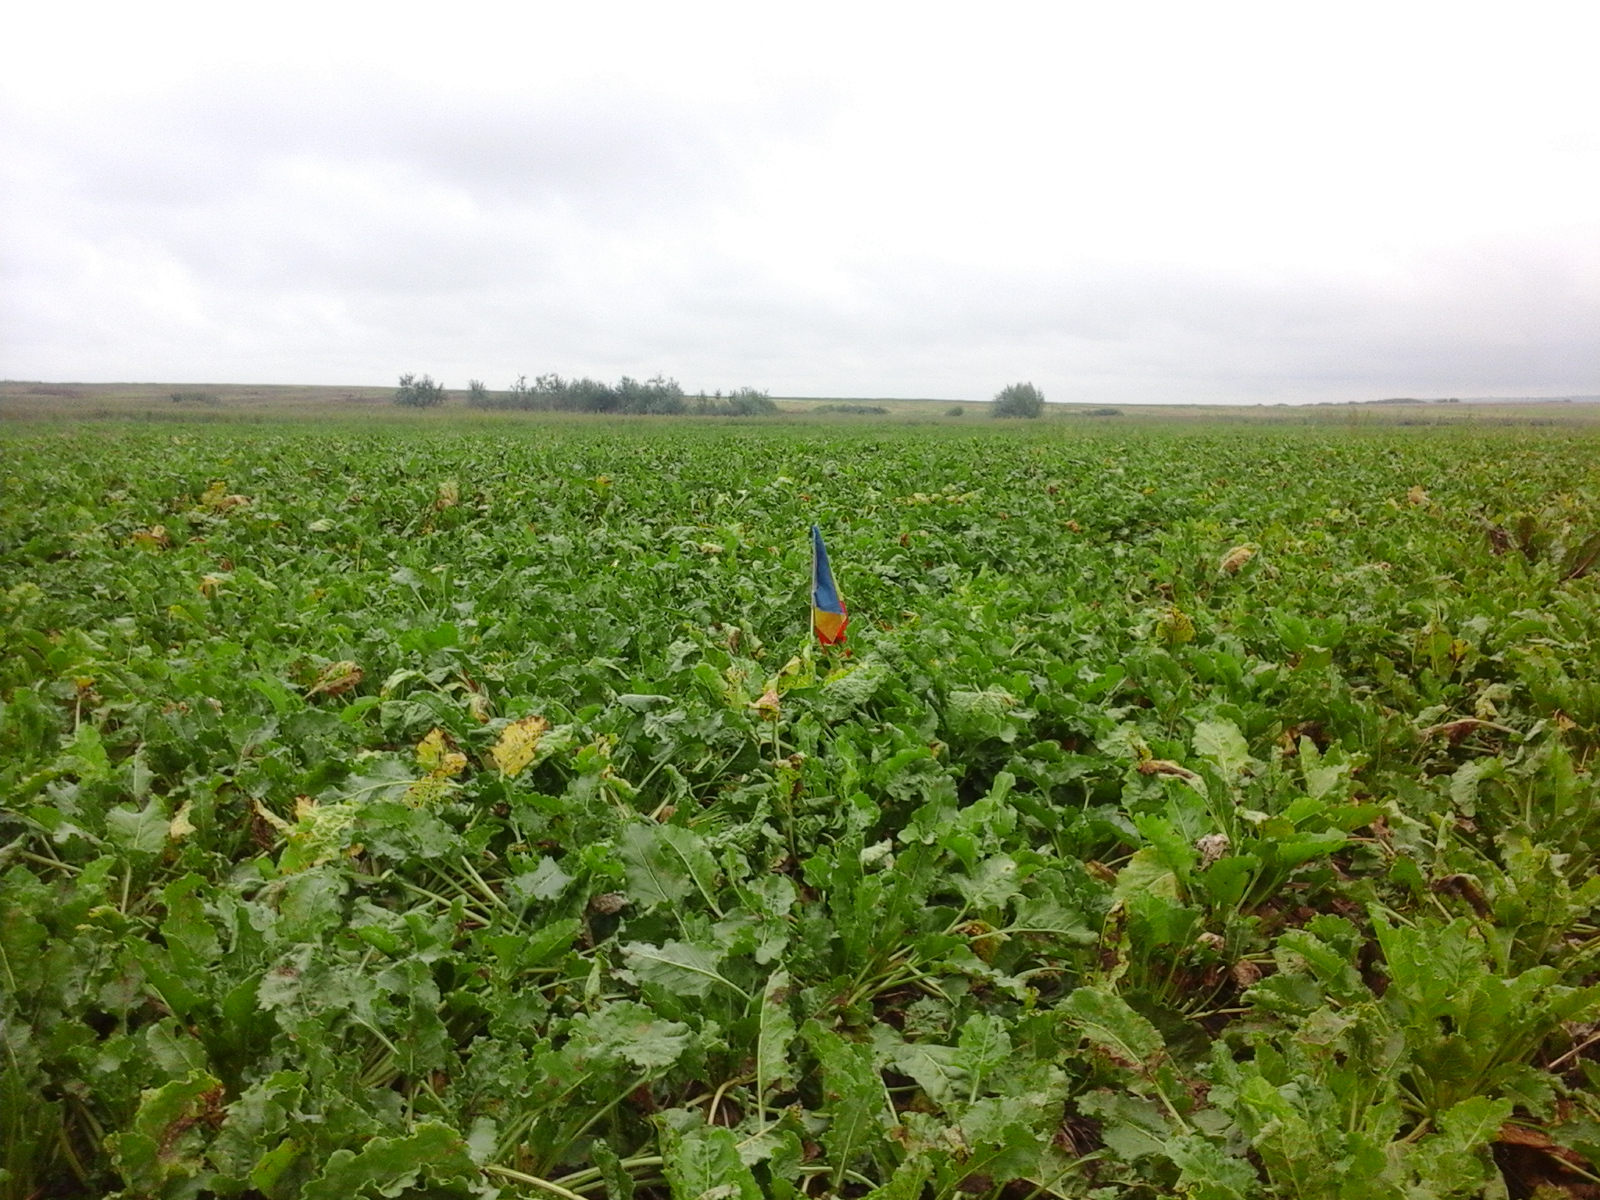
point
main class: Cropland
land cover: Sugar beet
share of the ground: > 75 %
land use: Agriculture (excluding fallow land and kitchen gardens)
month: September
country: RO
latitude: 47.1604
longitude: 21.8781
